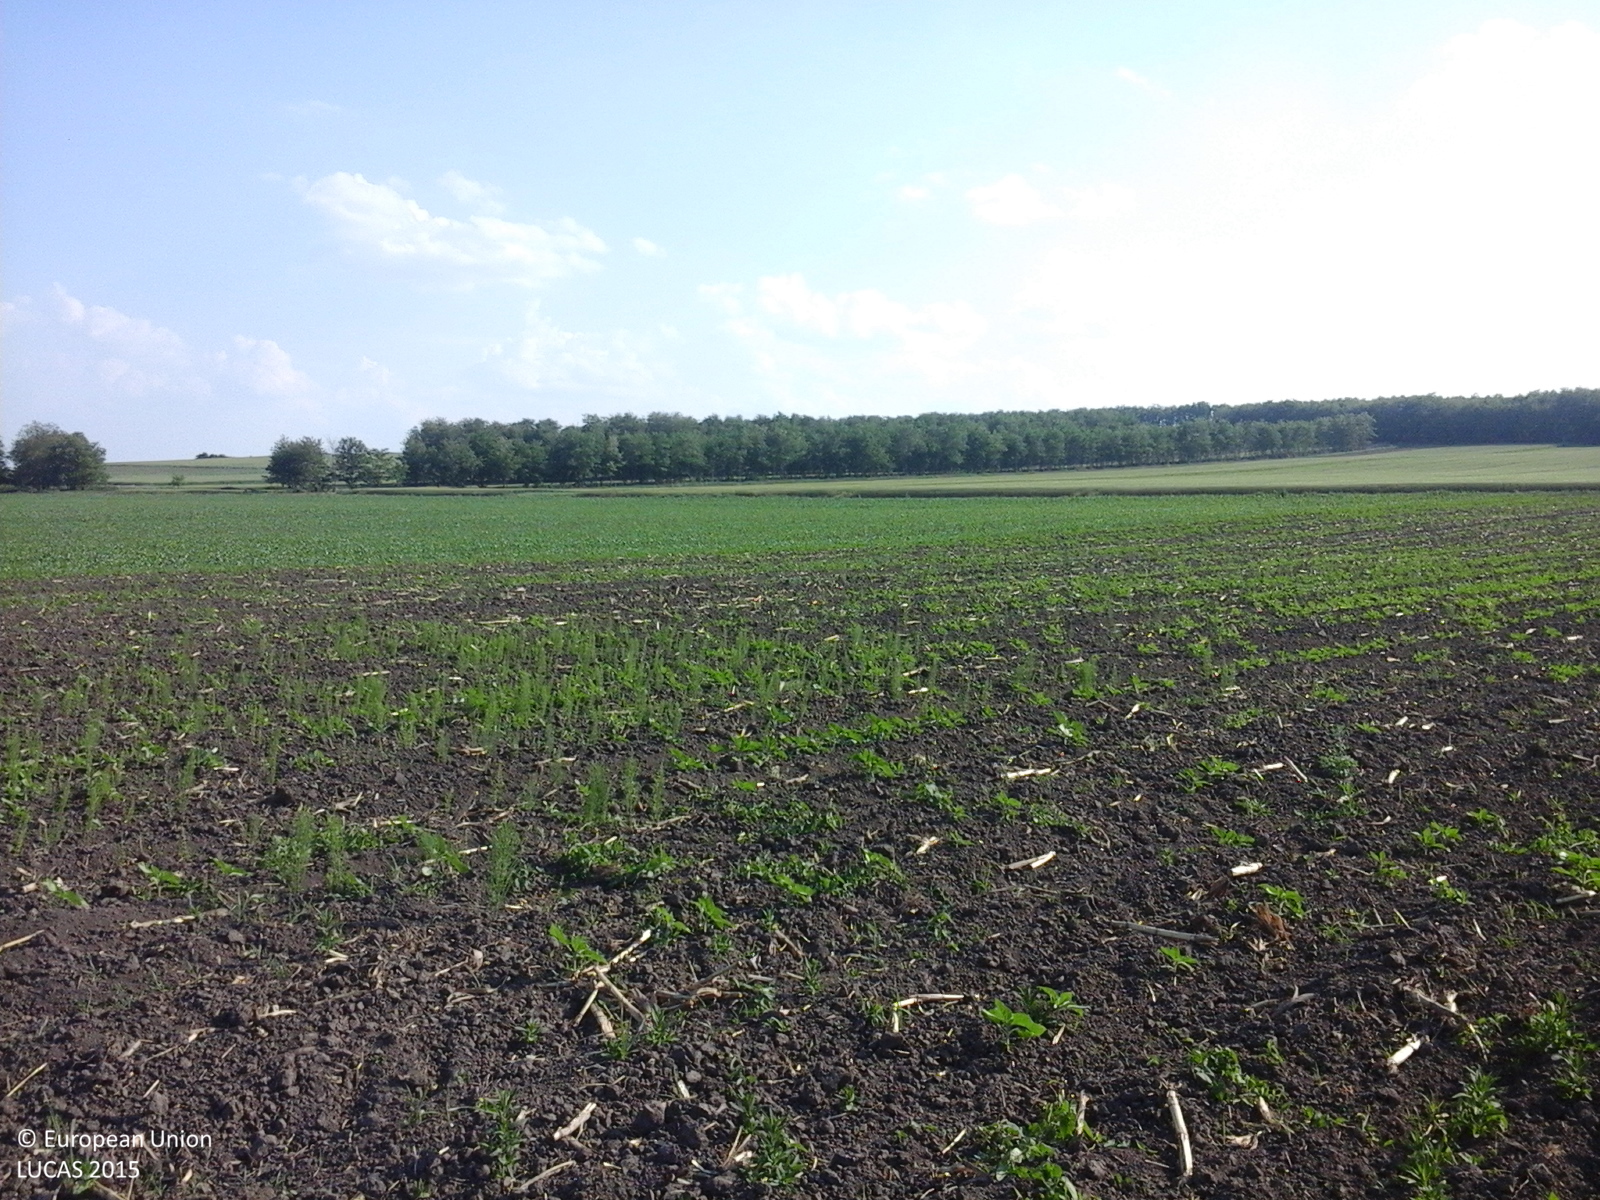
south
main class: Cropland
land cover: Sunflower
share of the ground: < 10 %
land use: Agriculture (excluding fallow land and kitchen gardens)
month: June
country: RO
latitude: 46.9754
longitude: 26.6930
